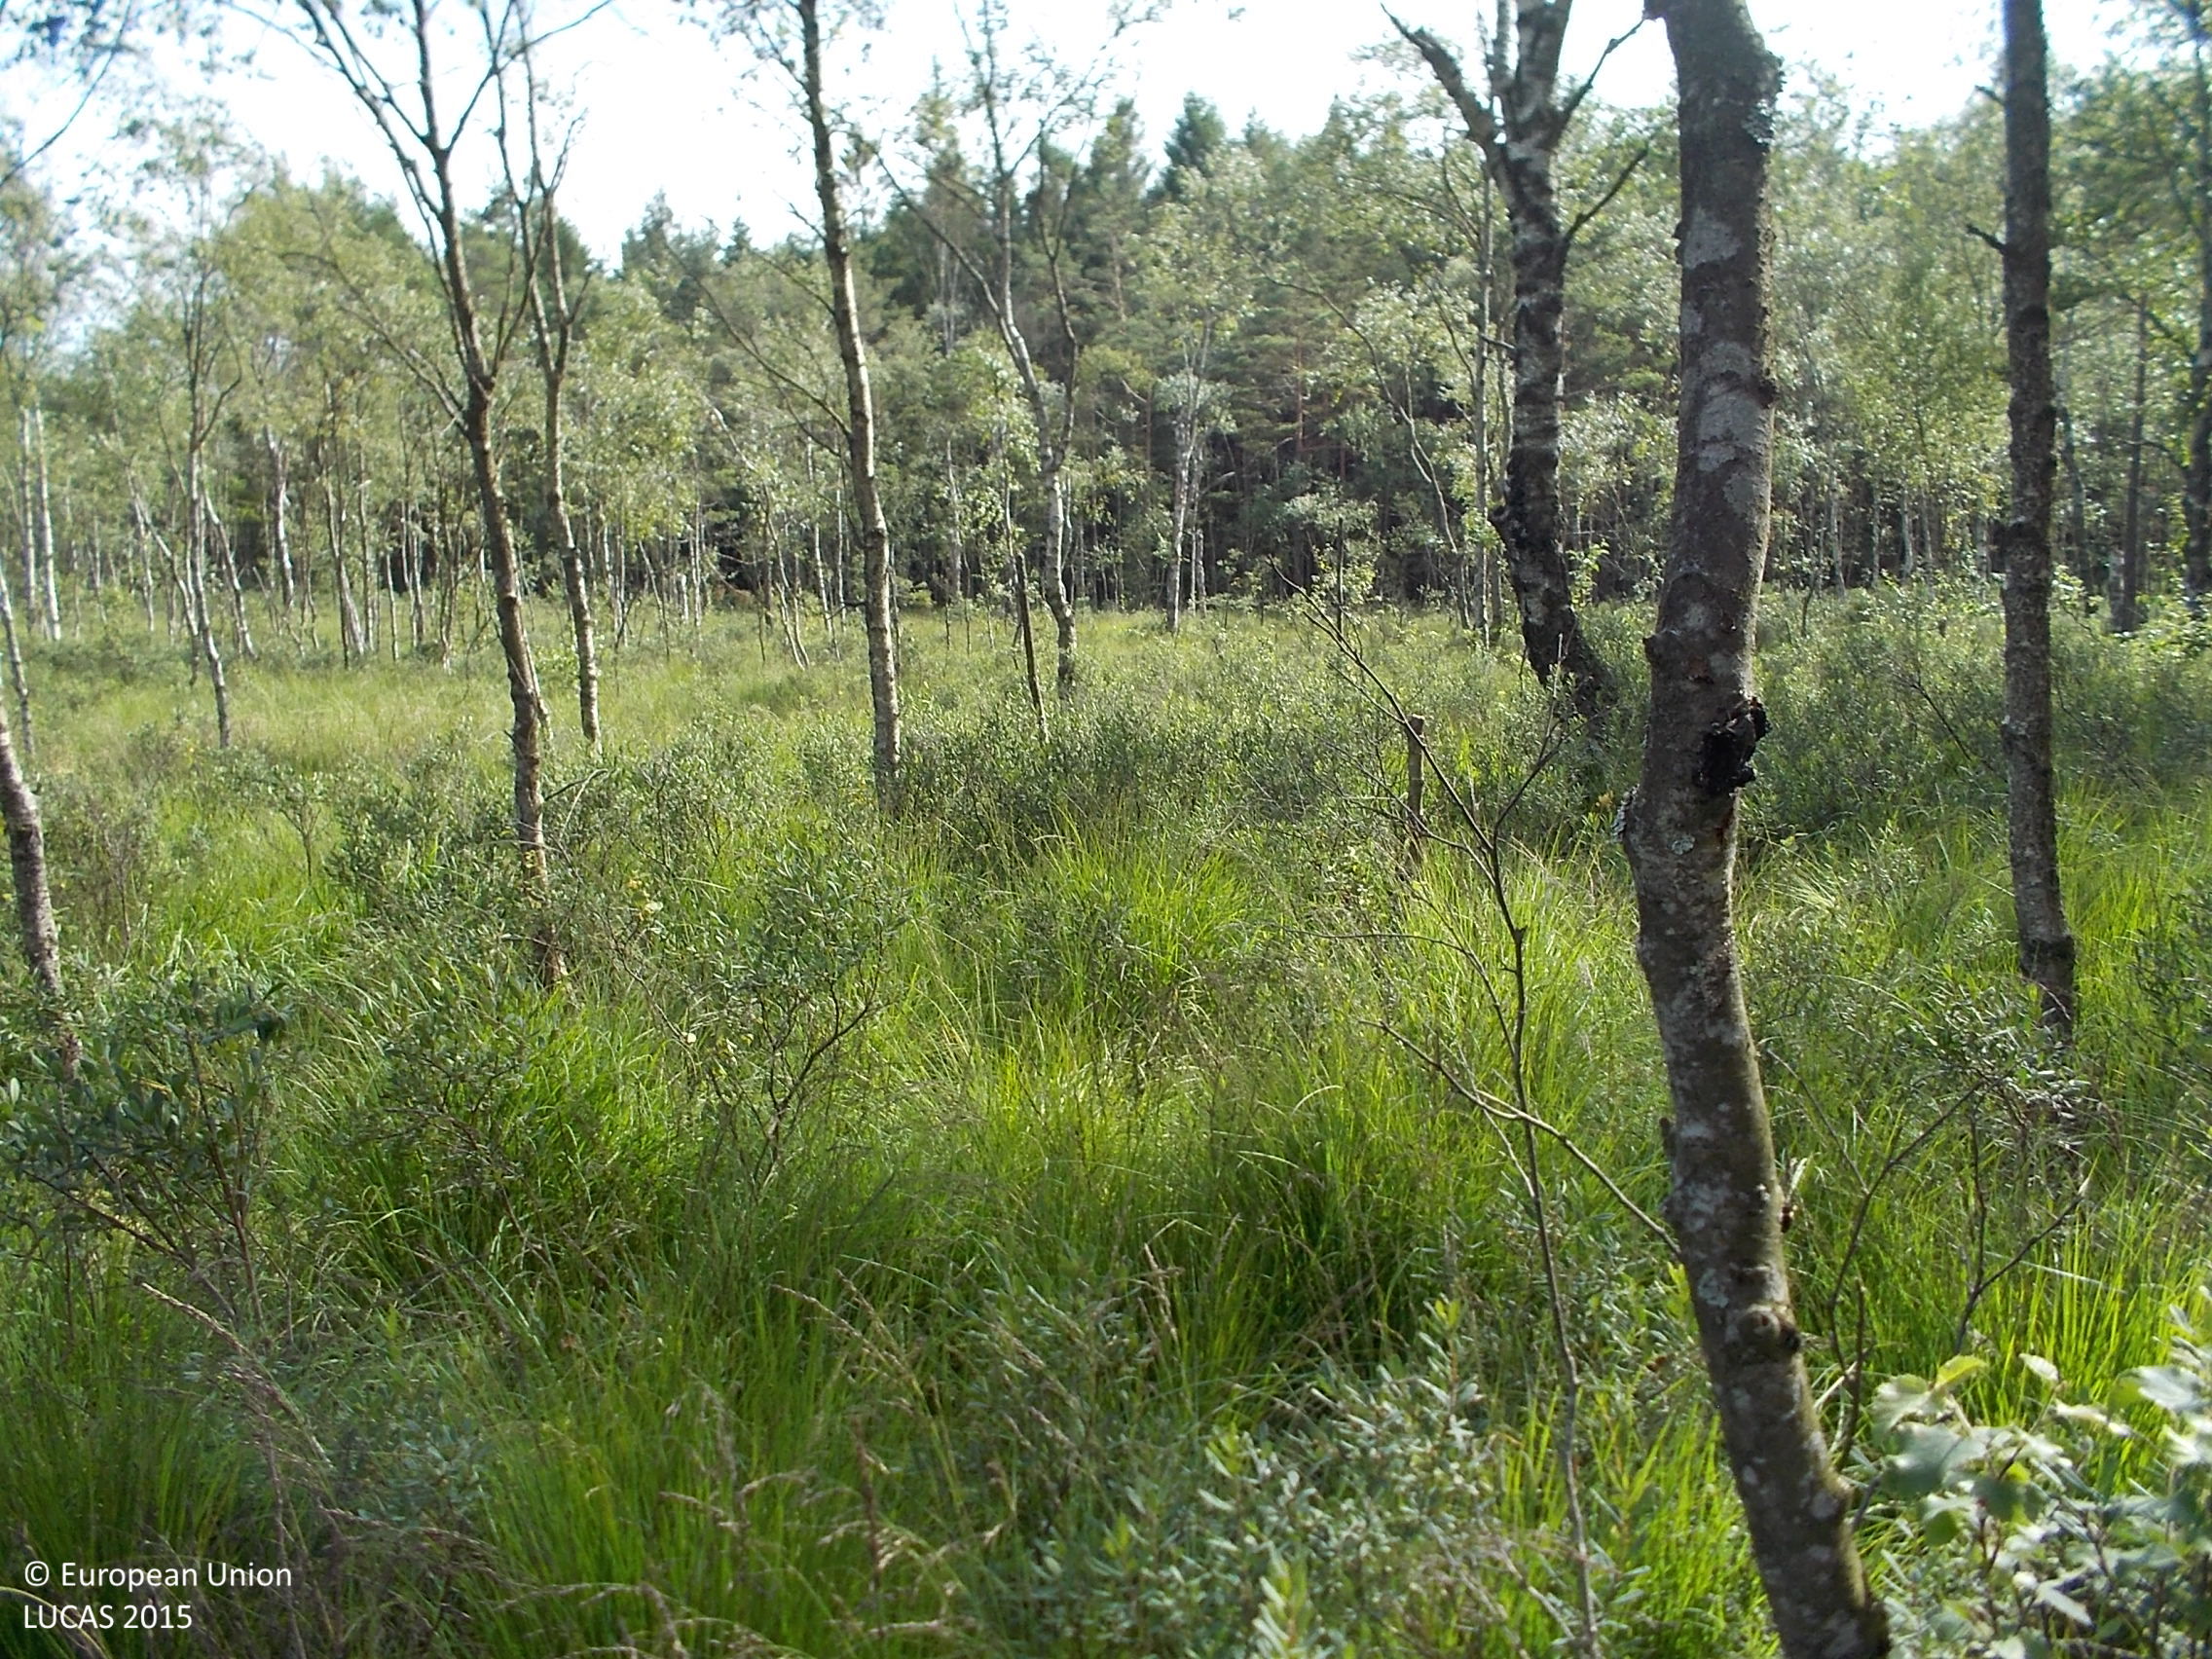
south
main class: Woodland
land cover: Pine dominated mixed woodland
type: mire and swamp forests
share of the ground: 25 - 50 %
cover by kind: herbaceous plants 30 %, coniferous forest trees 25 %, broadleaved forest trees 25 %, shrubs 20 %
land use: Semi-natural and natural areas not in use
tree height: > 5 m
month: August
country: SE
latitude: 57.5361
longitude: 12.1847
